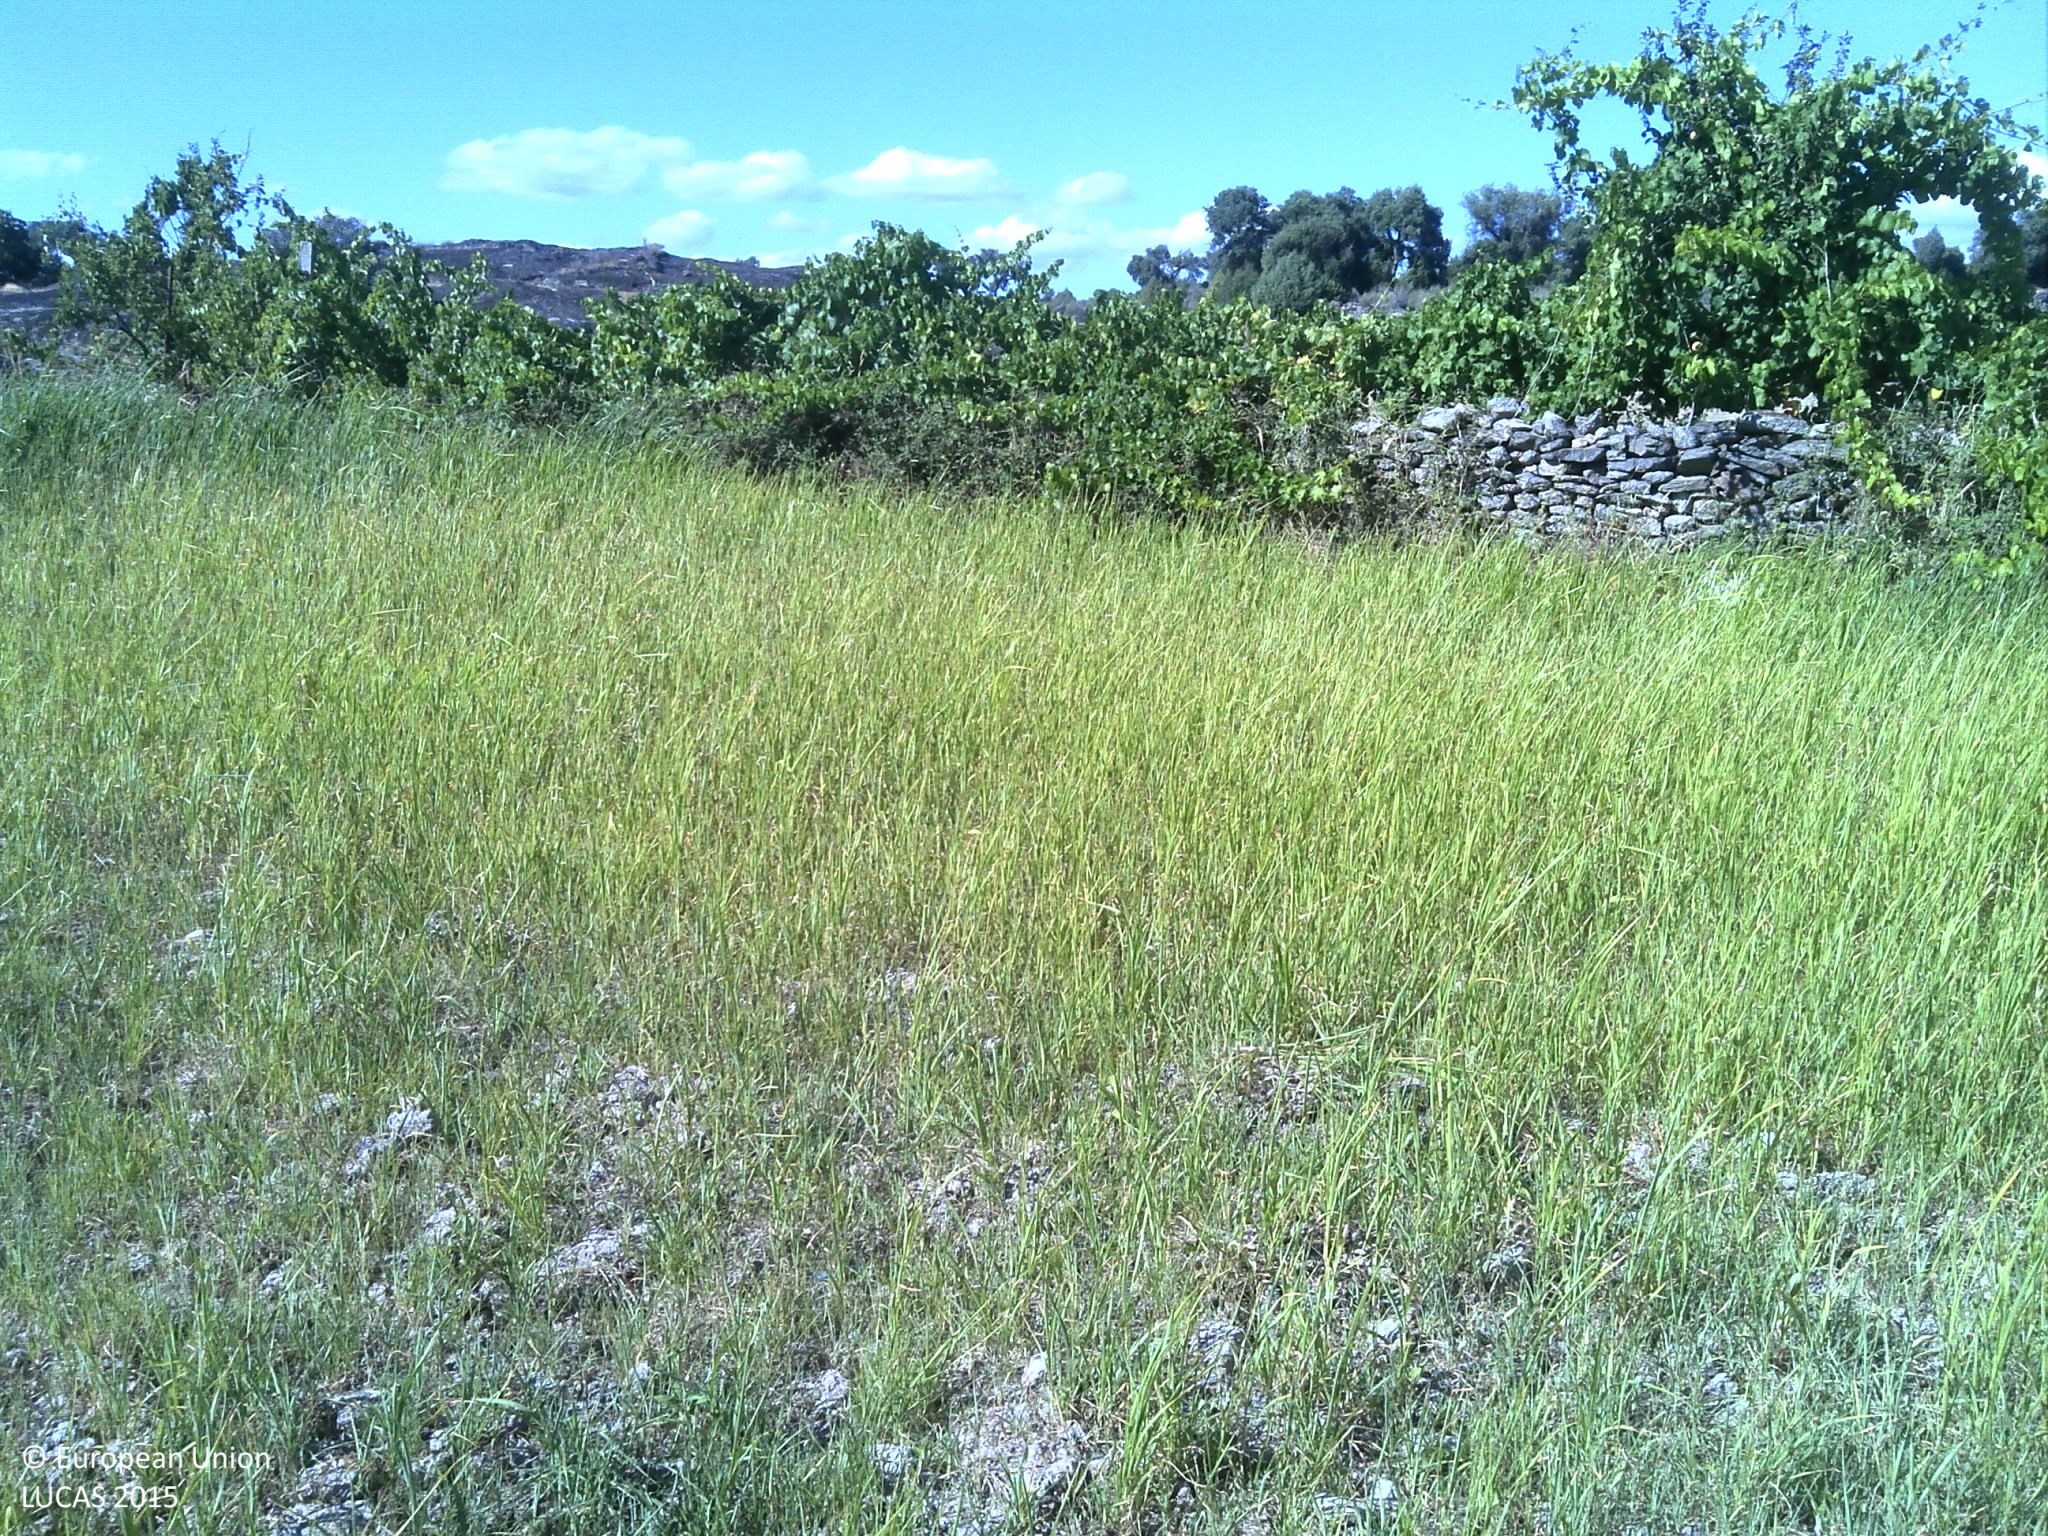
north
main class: Cropland
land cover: Other cereals
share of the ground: > 75 %
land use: Agriculture (excluding fallow land and kitchen gardens)
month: July
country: PT
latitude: 41.2517
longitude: -7.0462
